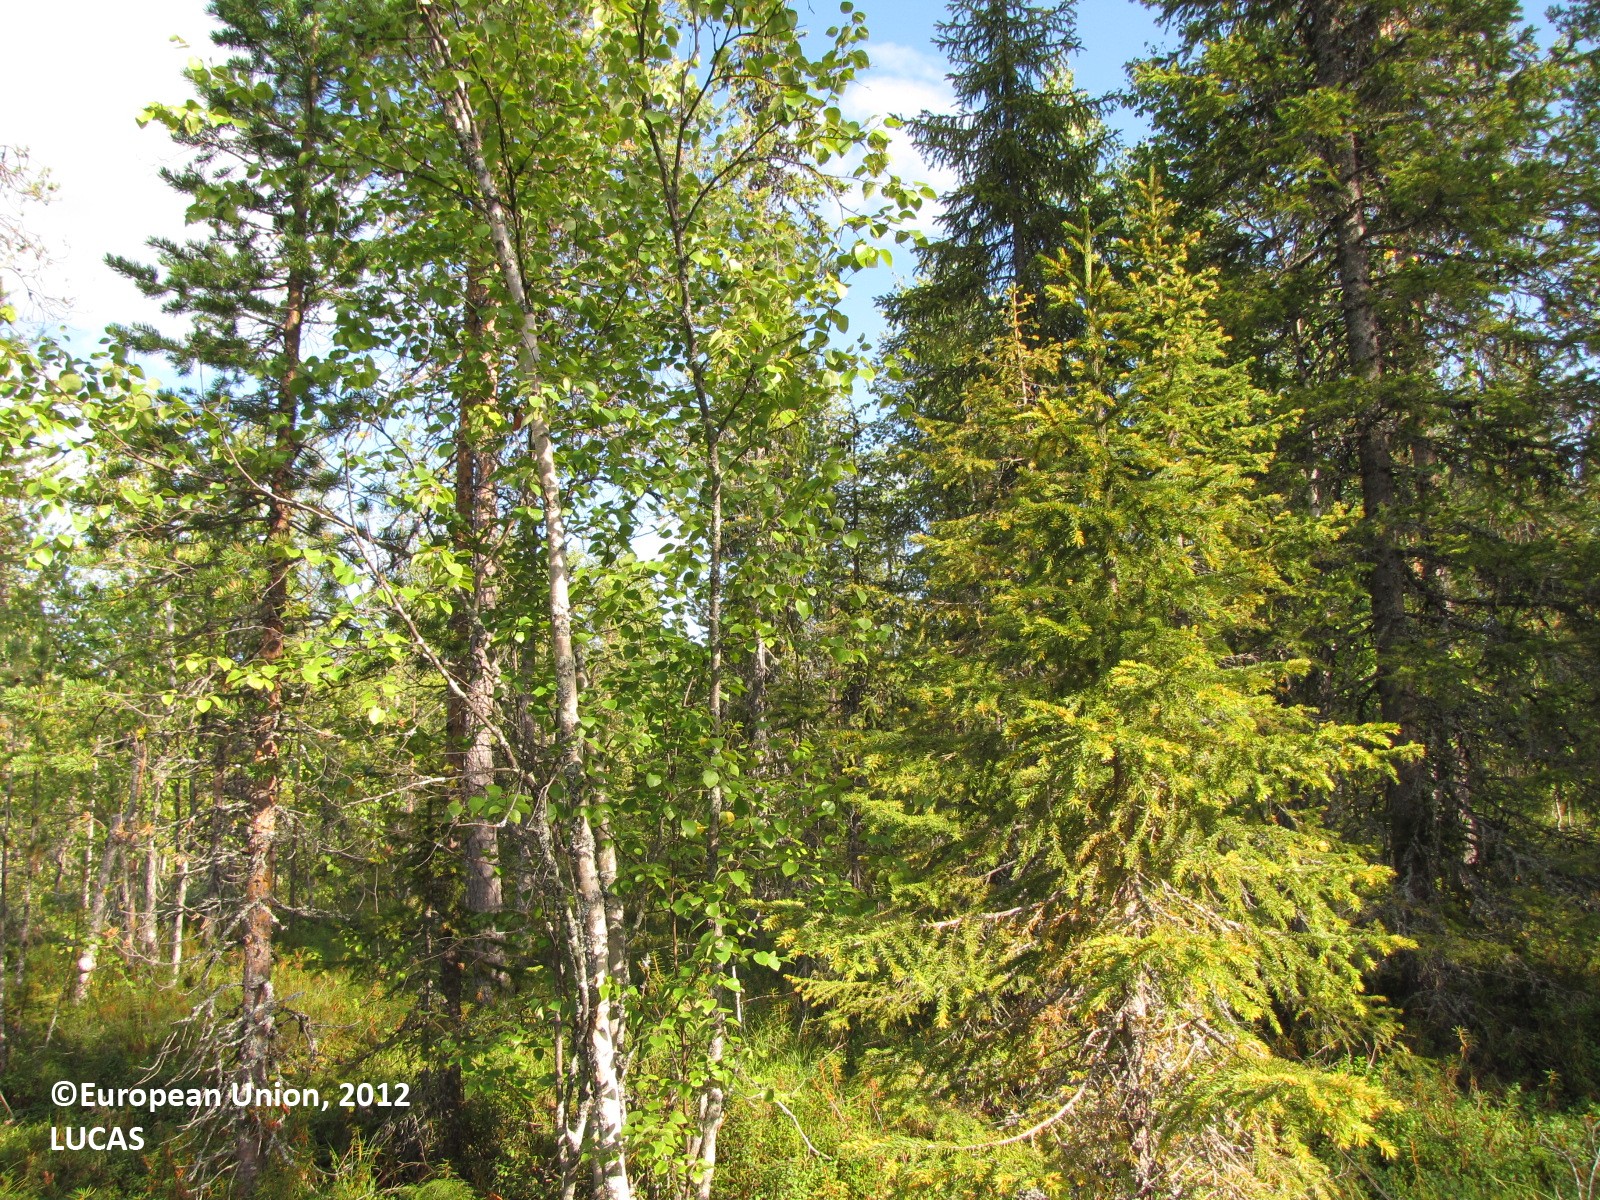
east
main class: Woodland
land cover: Pine dominated mixed woodland
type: boreal forest
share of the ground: 25 - 50 %
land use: Forestry
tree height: > 5 m
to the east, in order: Pine dominated mixed woodland; Tracks; Pine dominated mixed woodland; Tracks; Pine dominated mixed woodland
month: August
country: FI
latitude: 66.9681
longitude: 25.2375
